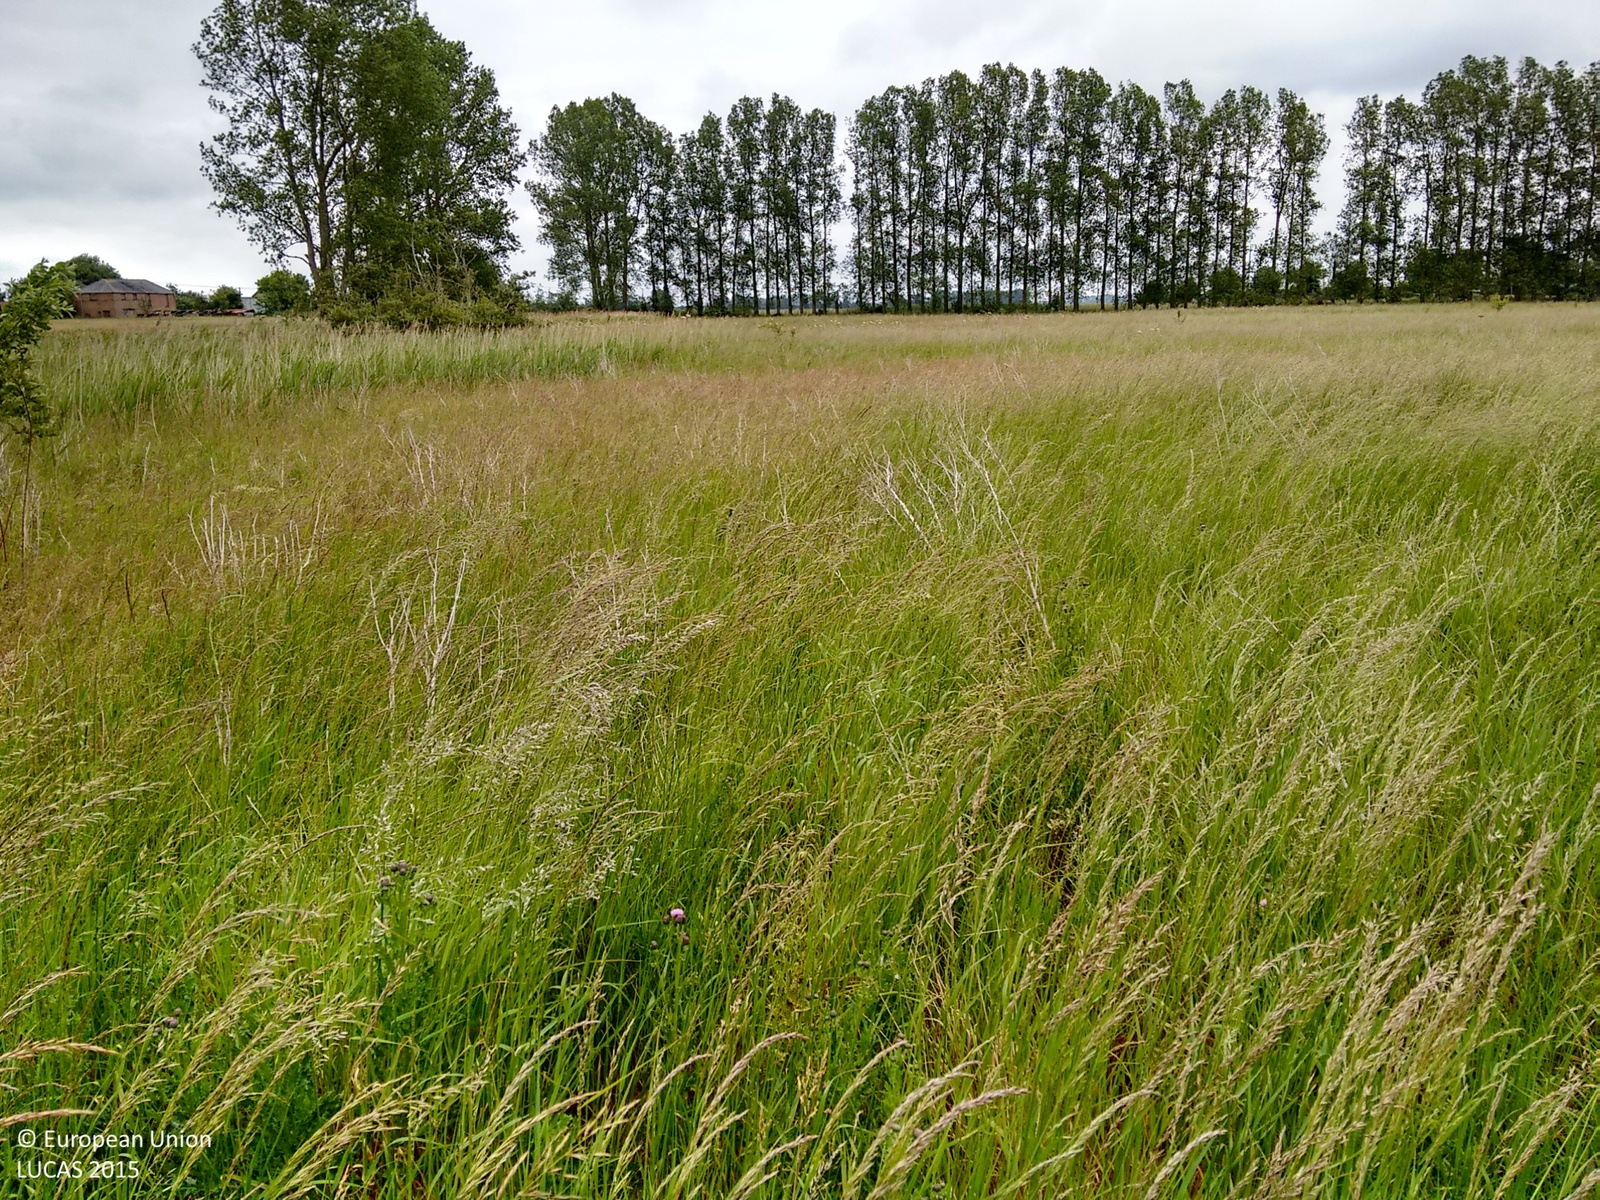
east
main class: Grassland
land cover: Grassland without tree/shrub cover
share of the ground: > 75 %
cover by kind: herbaceous plants 100 %
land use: Sport
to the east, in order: Grassland without tree/shrub cover; Ditches and canals; Lines of trees; Grass margins; Common wheat
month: June
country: GB
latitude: 52.7351
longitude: 0.2399
